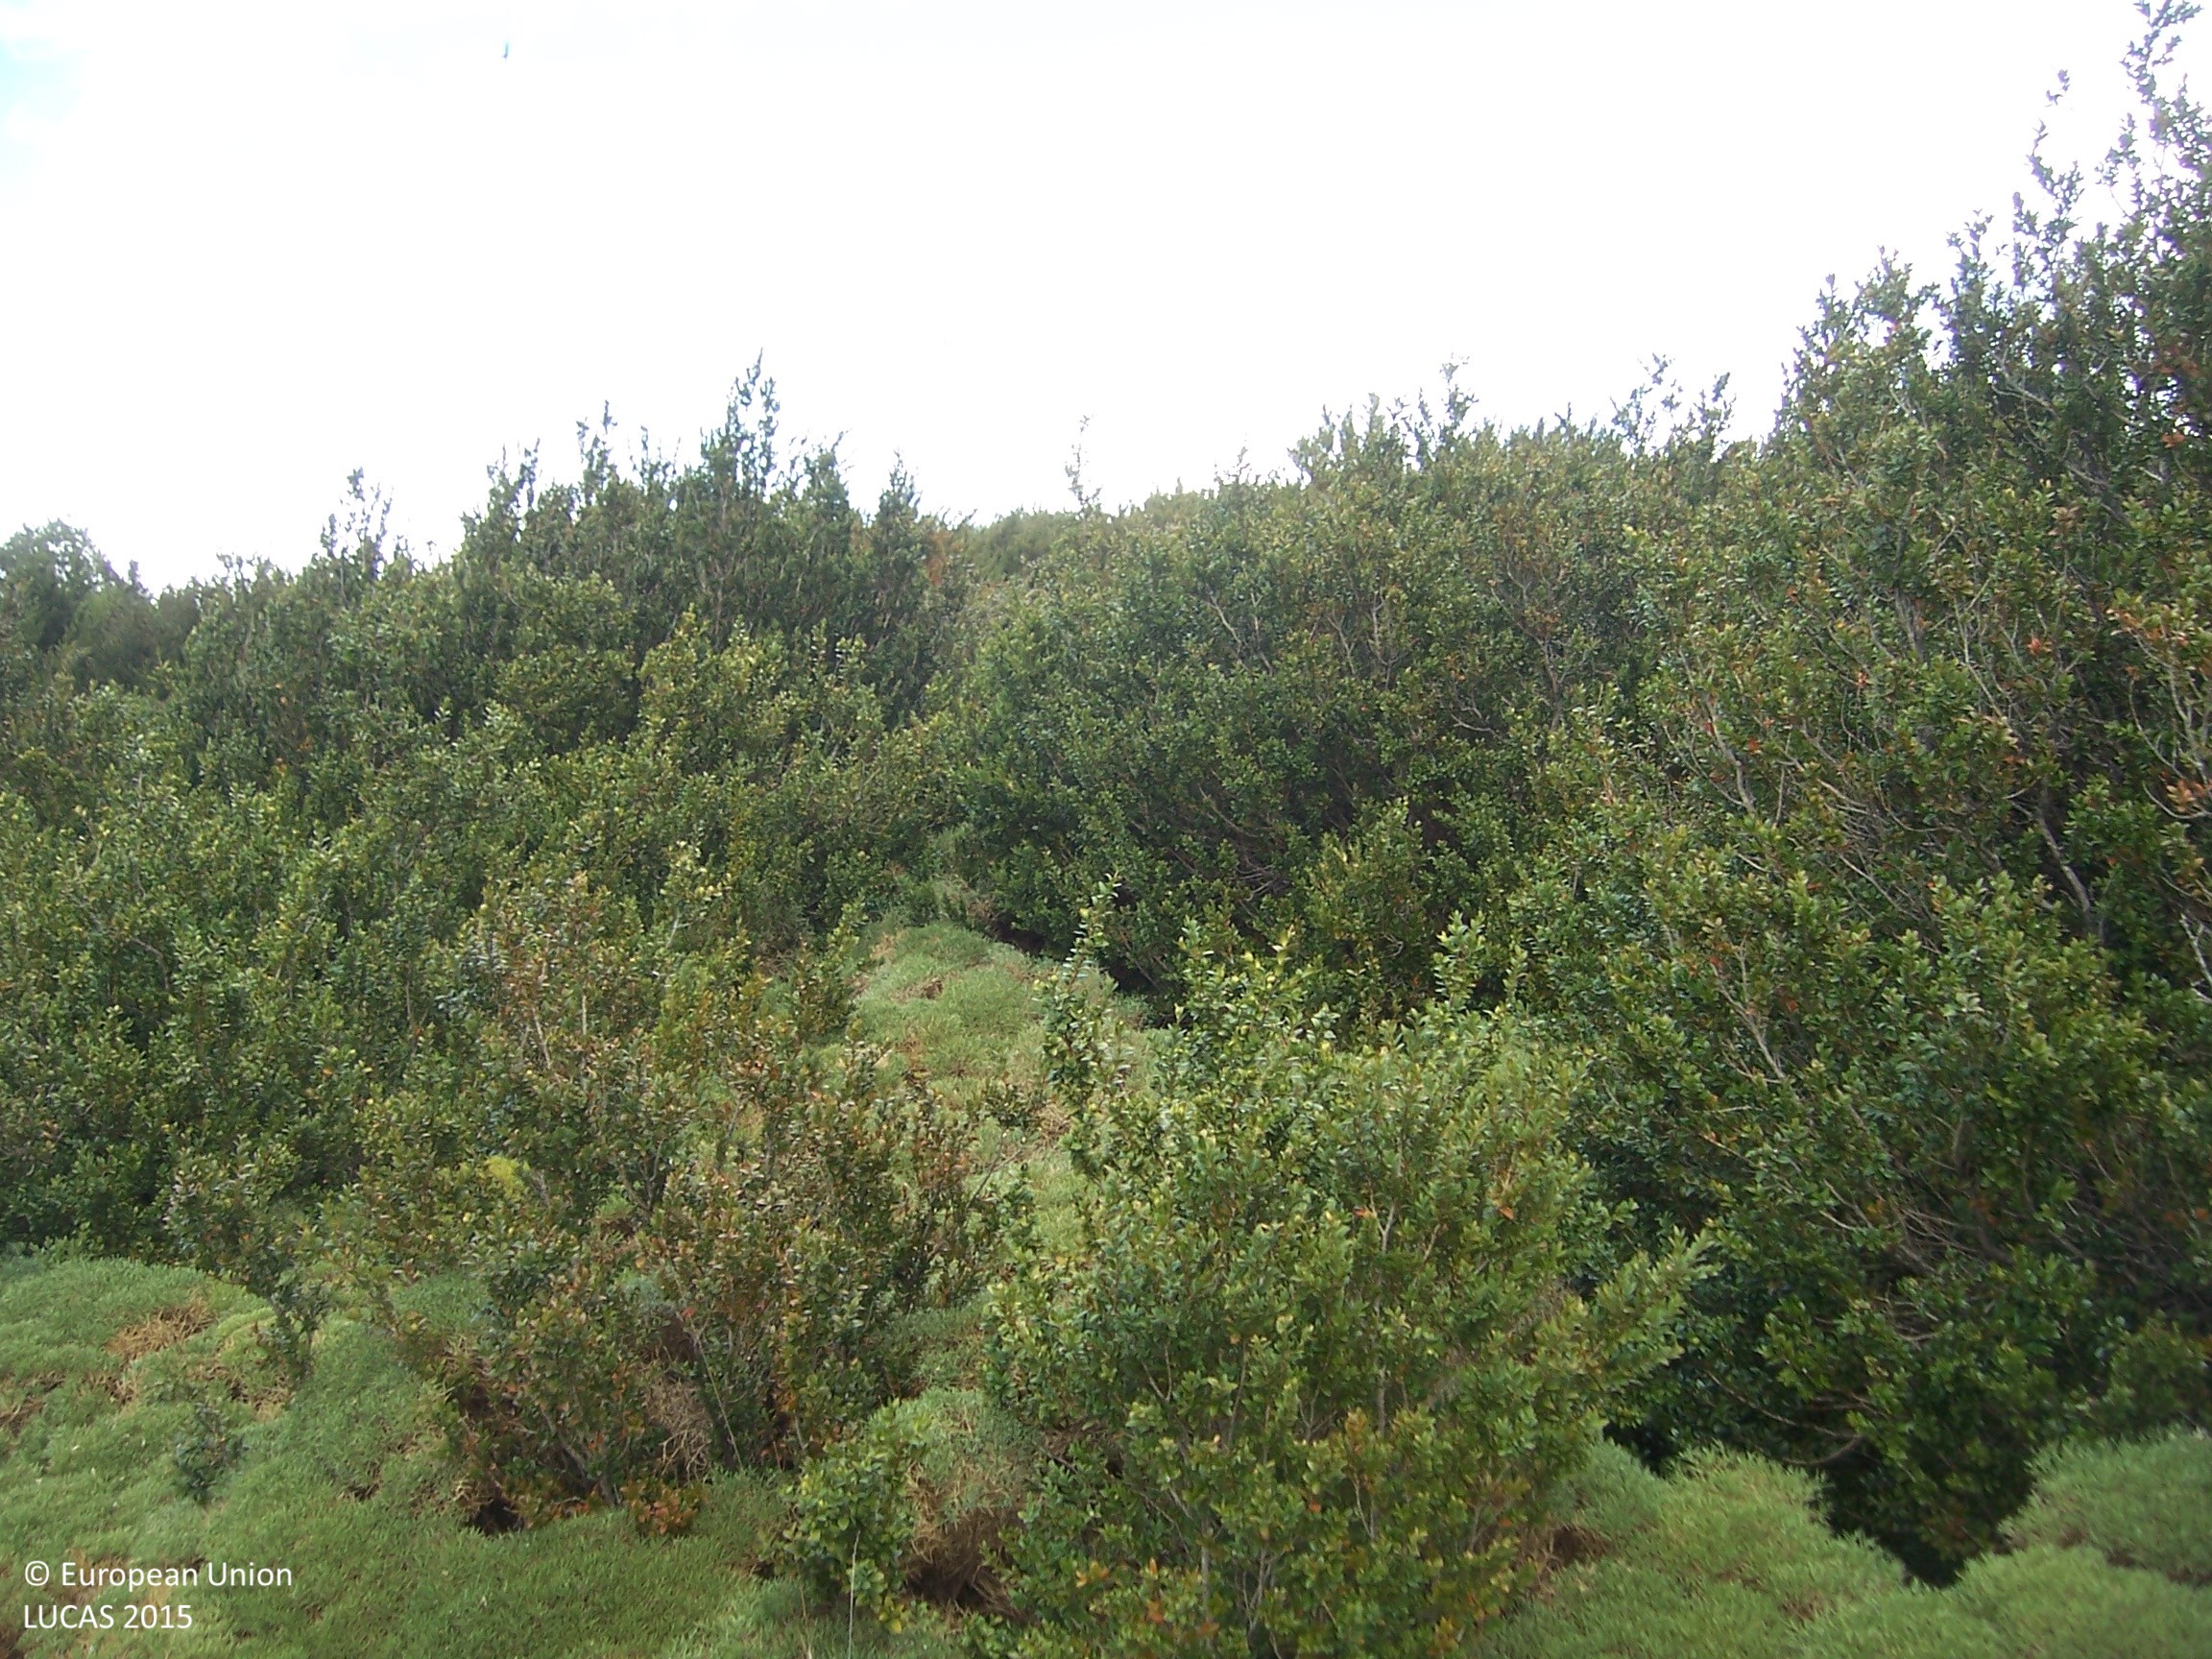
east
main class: Shrubland
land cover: Shrubland without tree cover
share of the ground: > 75 %
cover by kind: shrubs 90 %, consolidated bare surface 10 %
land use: Semi-natural and natural areas not in use
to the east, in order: Shrubland without tree cover; Shrubland with sparse tree cover; Tracks; Dry stone walls; Shrubland with sparse tree cover; Shrubland without tree cover
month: August
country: ES
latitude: 42.3387
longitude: -0.0106
